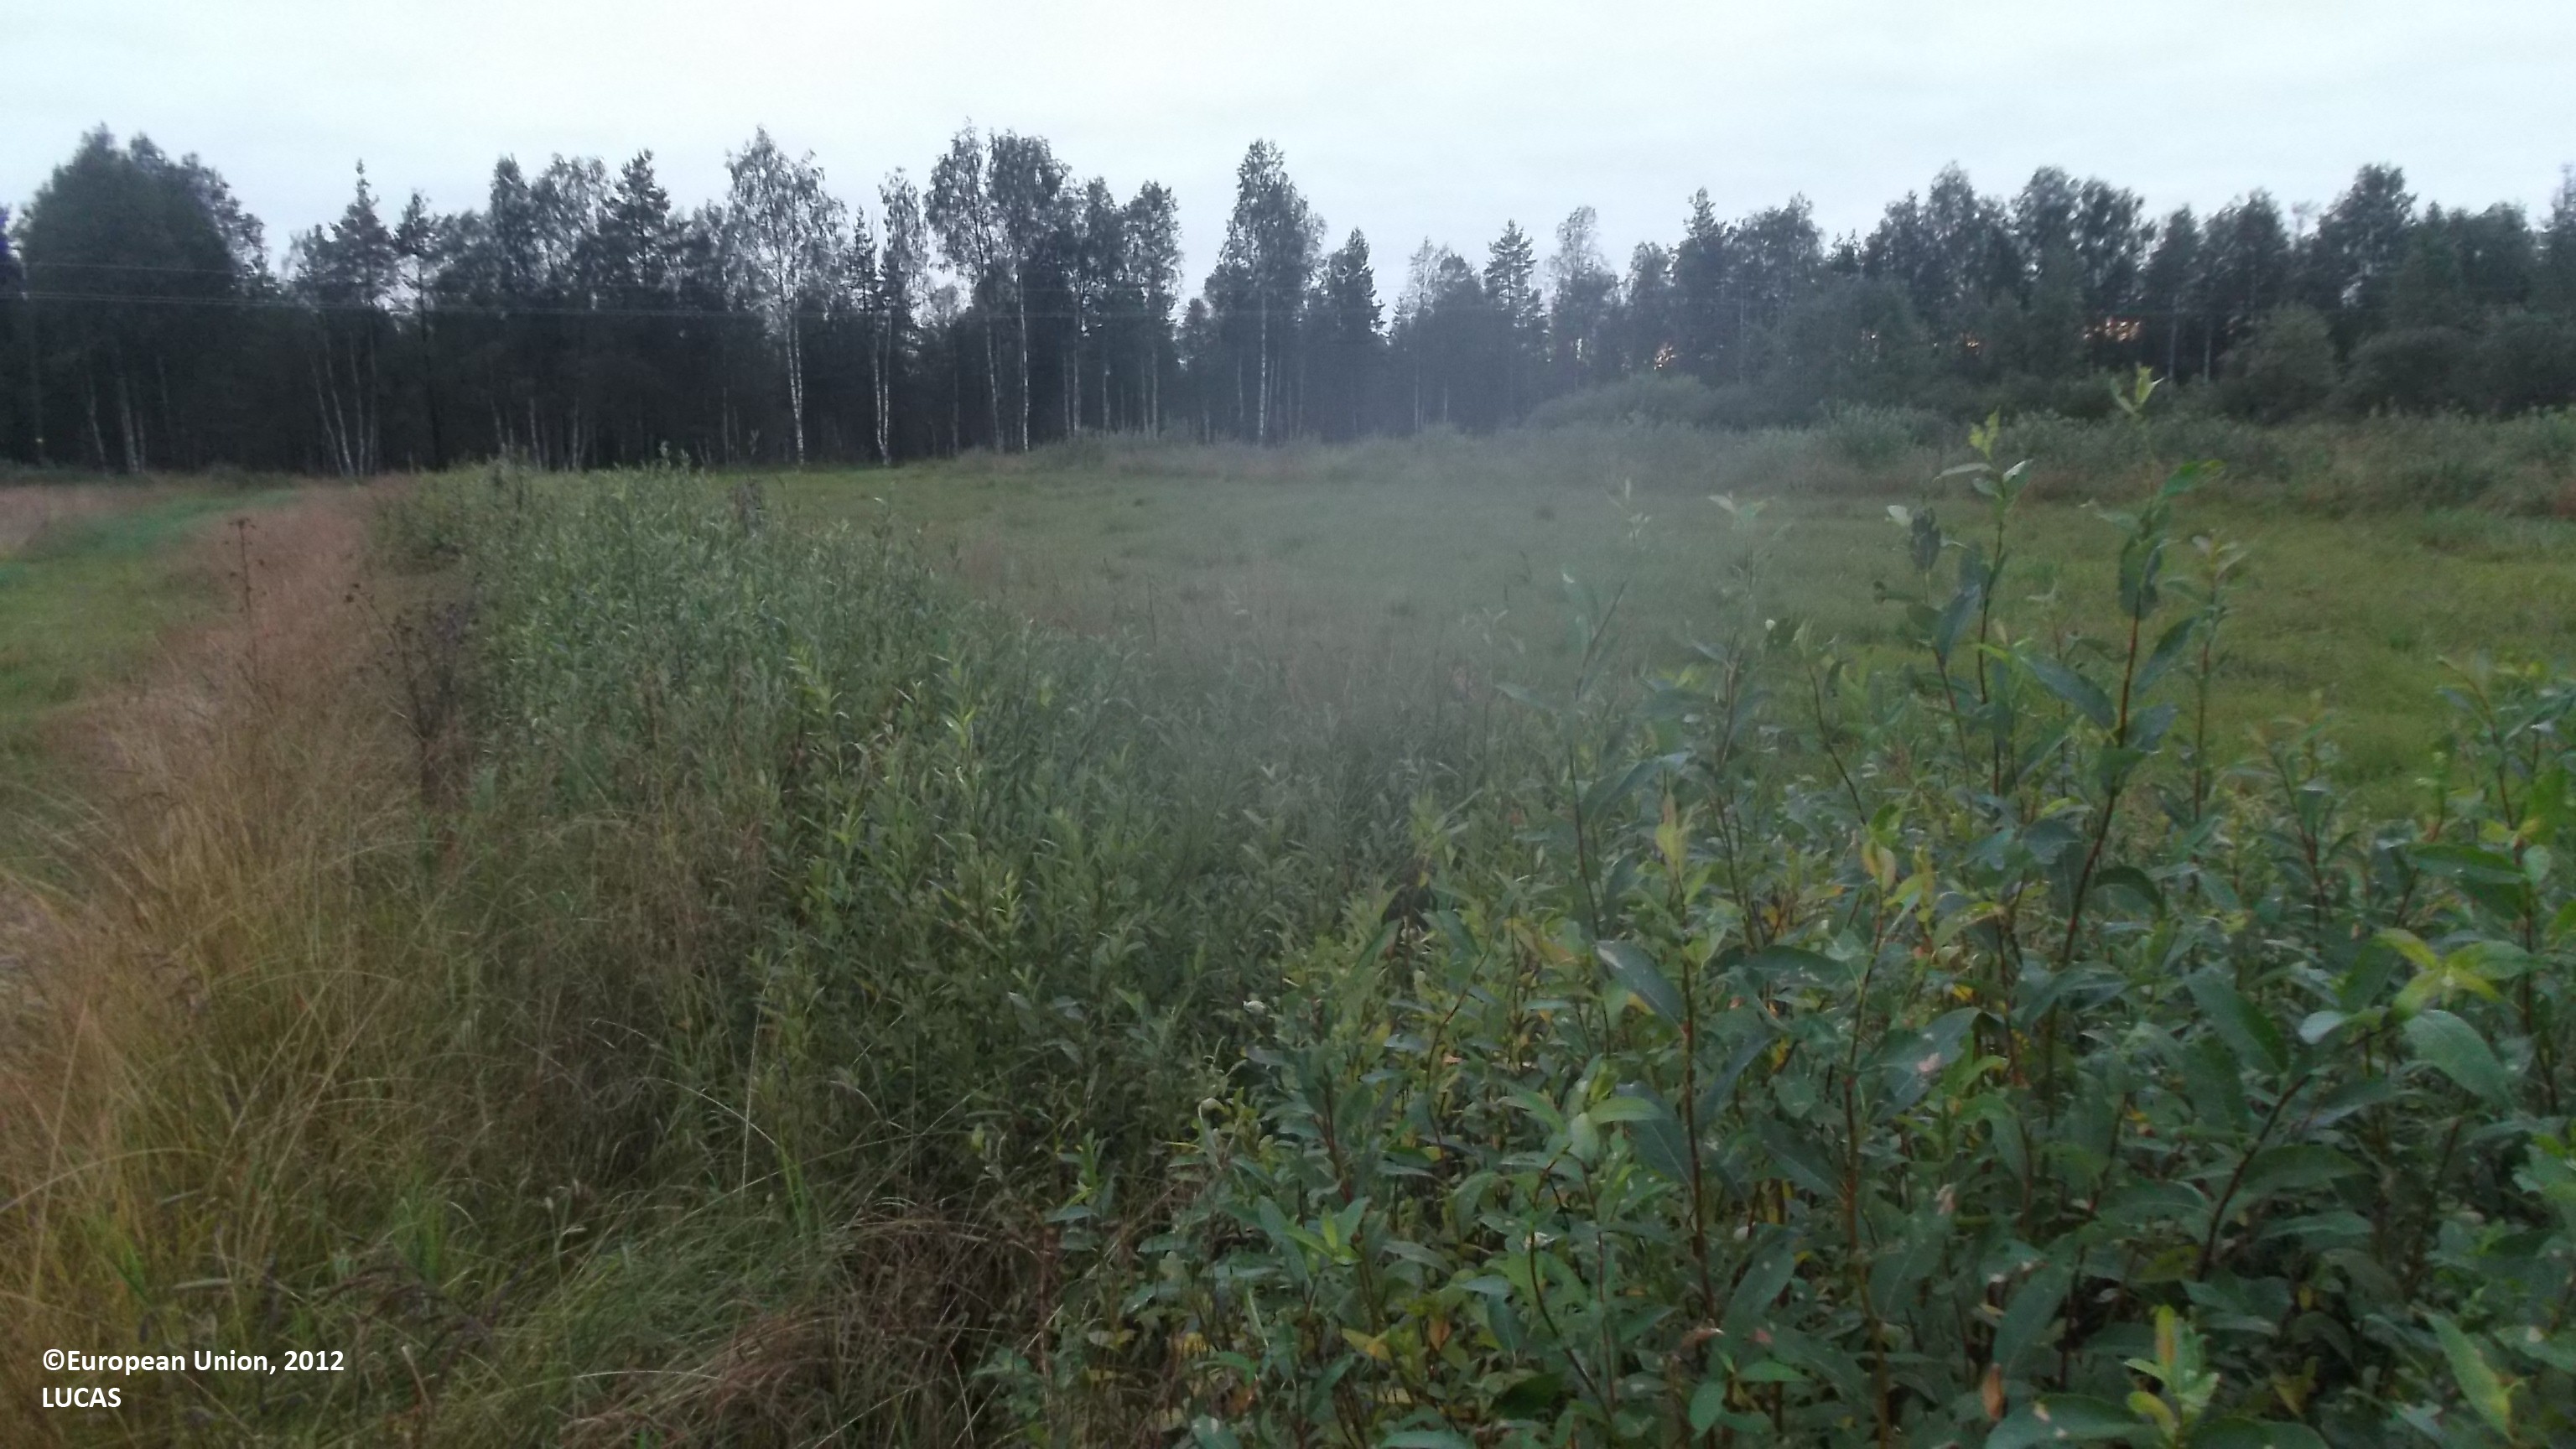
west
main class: Cropland
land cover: Temporary grasslands
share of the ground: > 75 %
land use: Agriculture (excluding fallow land and kitchen gardens)
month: August
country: FI
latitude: 63.2328
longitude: 24.4714
